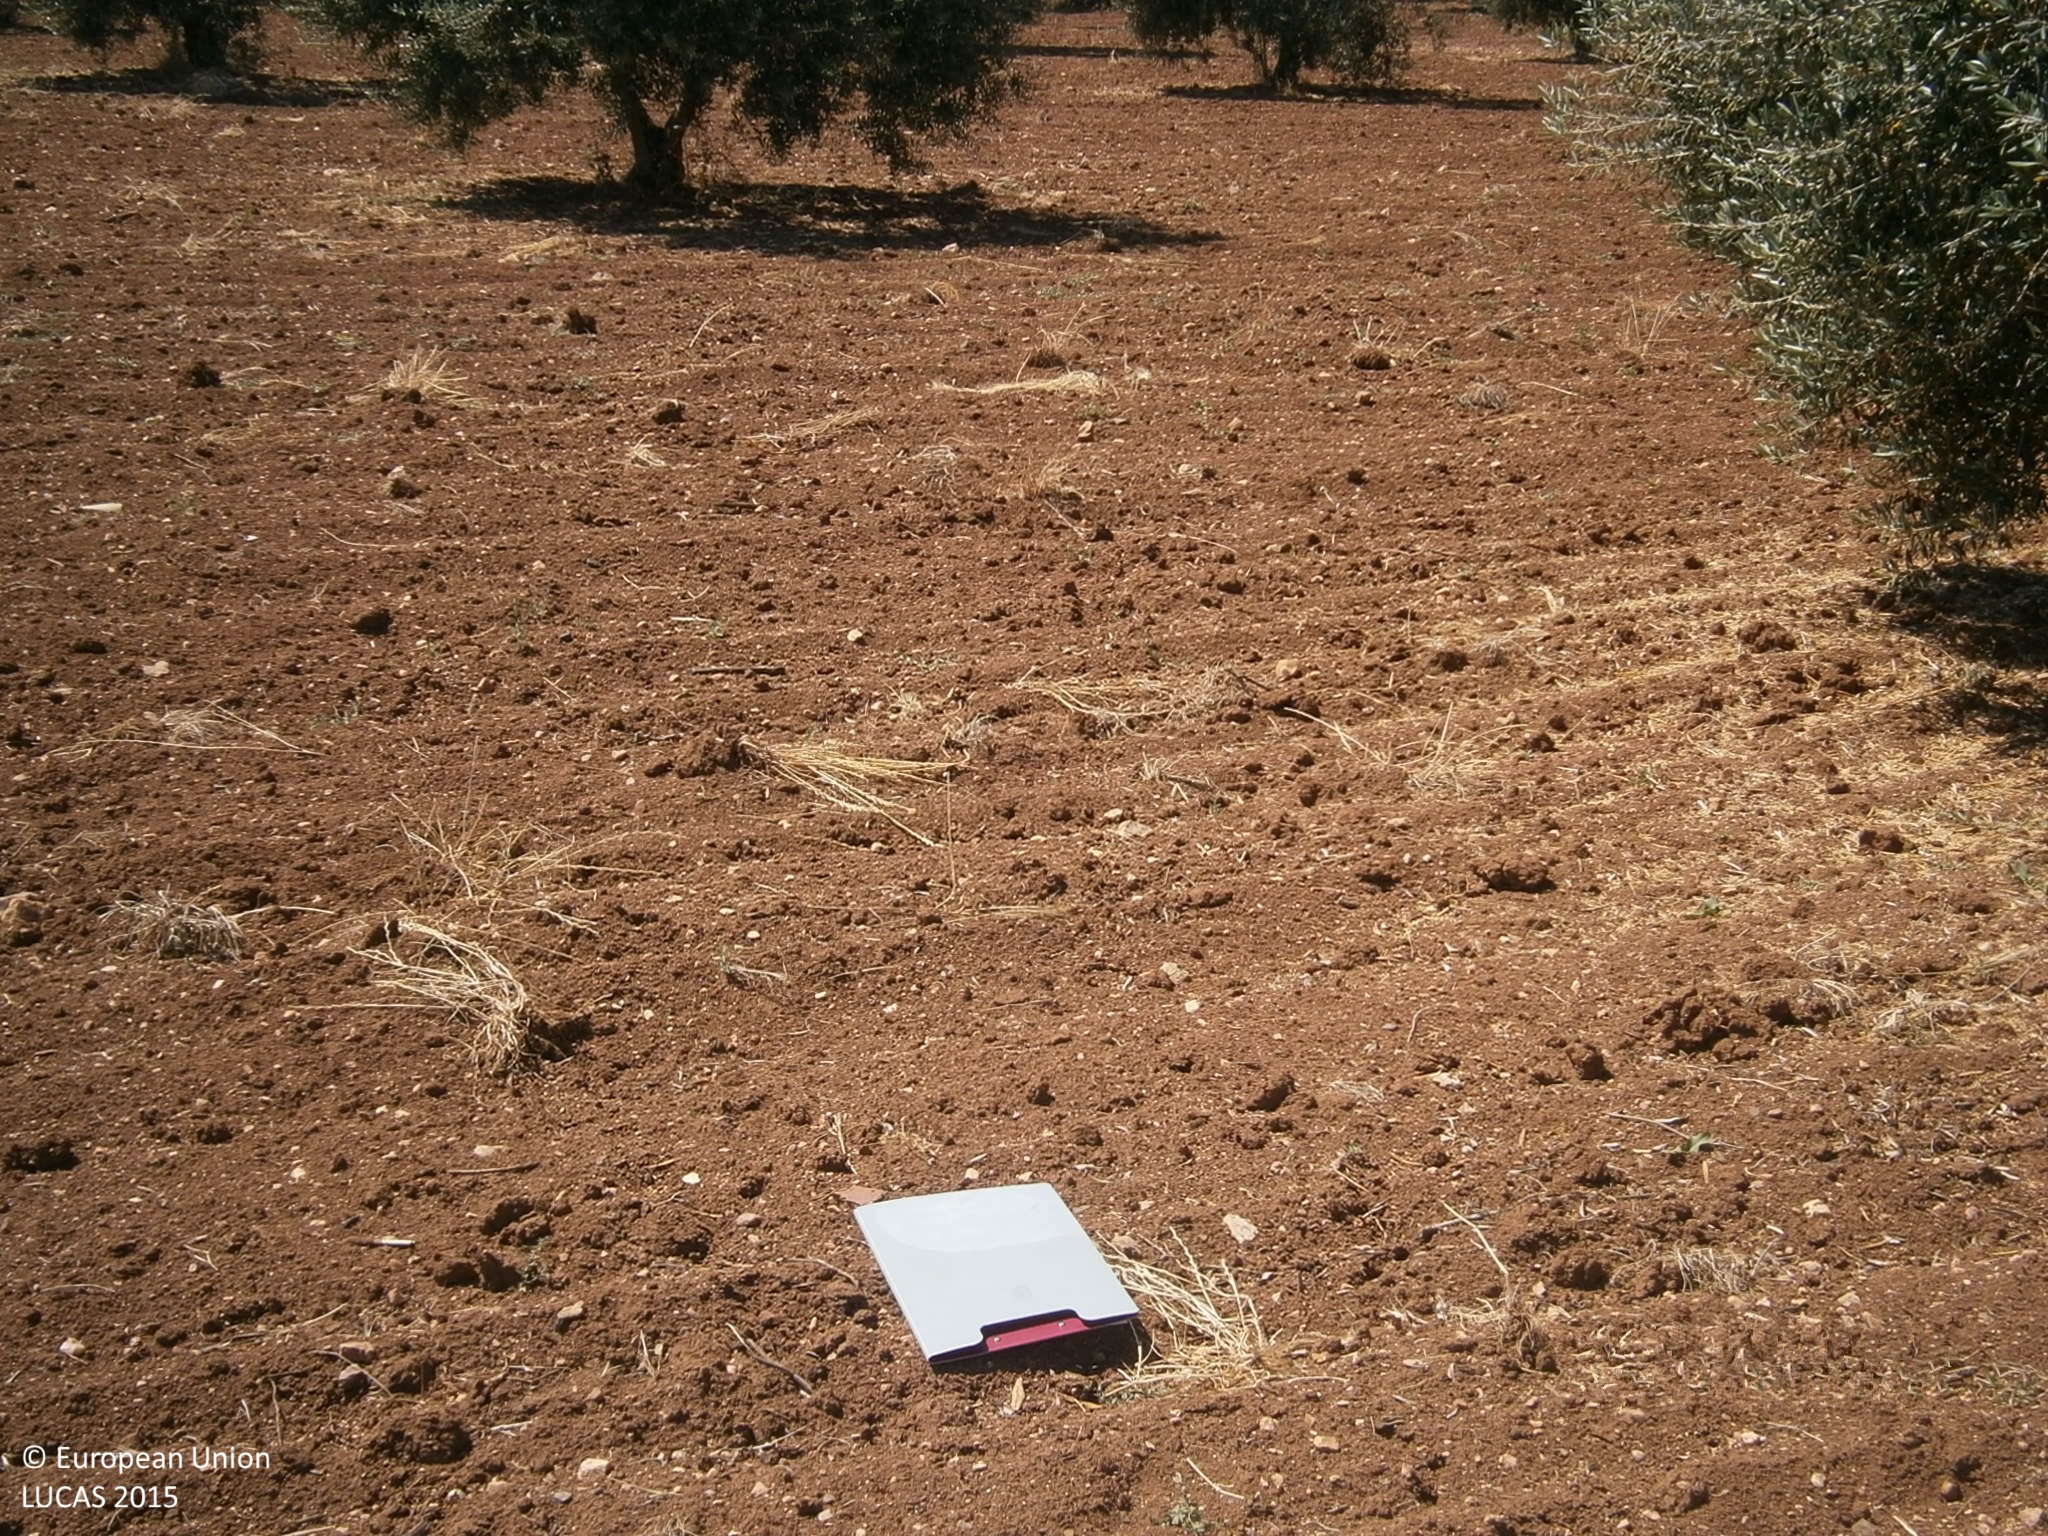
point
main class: Cropland
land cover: Olive groves
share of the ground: 25 - 50 %
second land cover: Other bare soil
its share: > 75 %
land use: Agriculture (excluding fallow land and kitchen gardens)
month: June
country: ES
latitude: 38.5977
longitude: -6.4152
